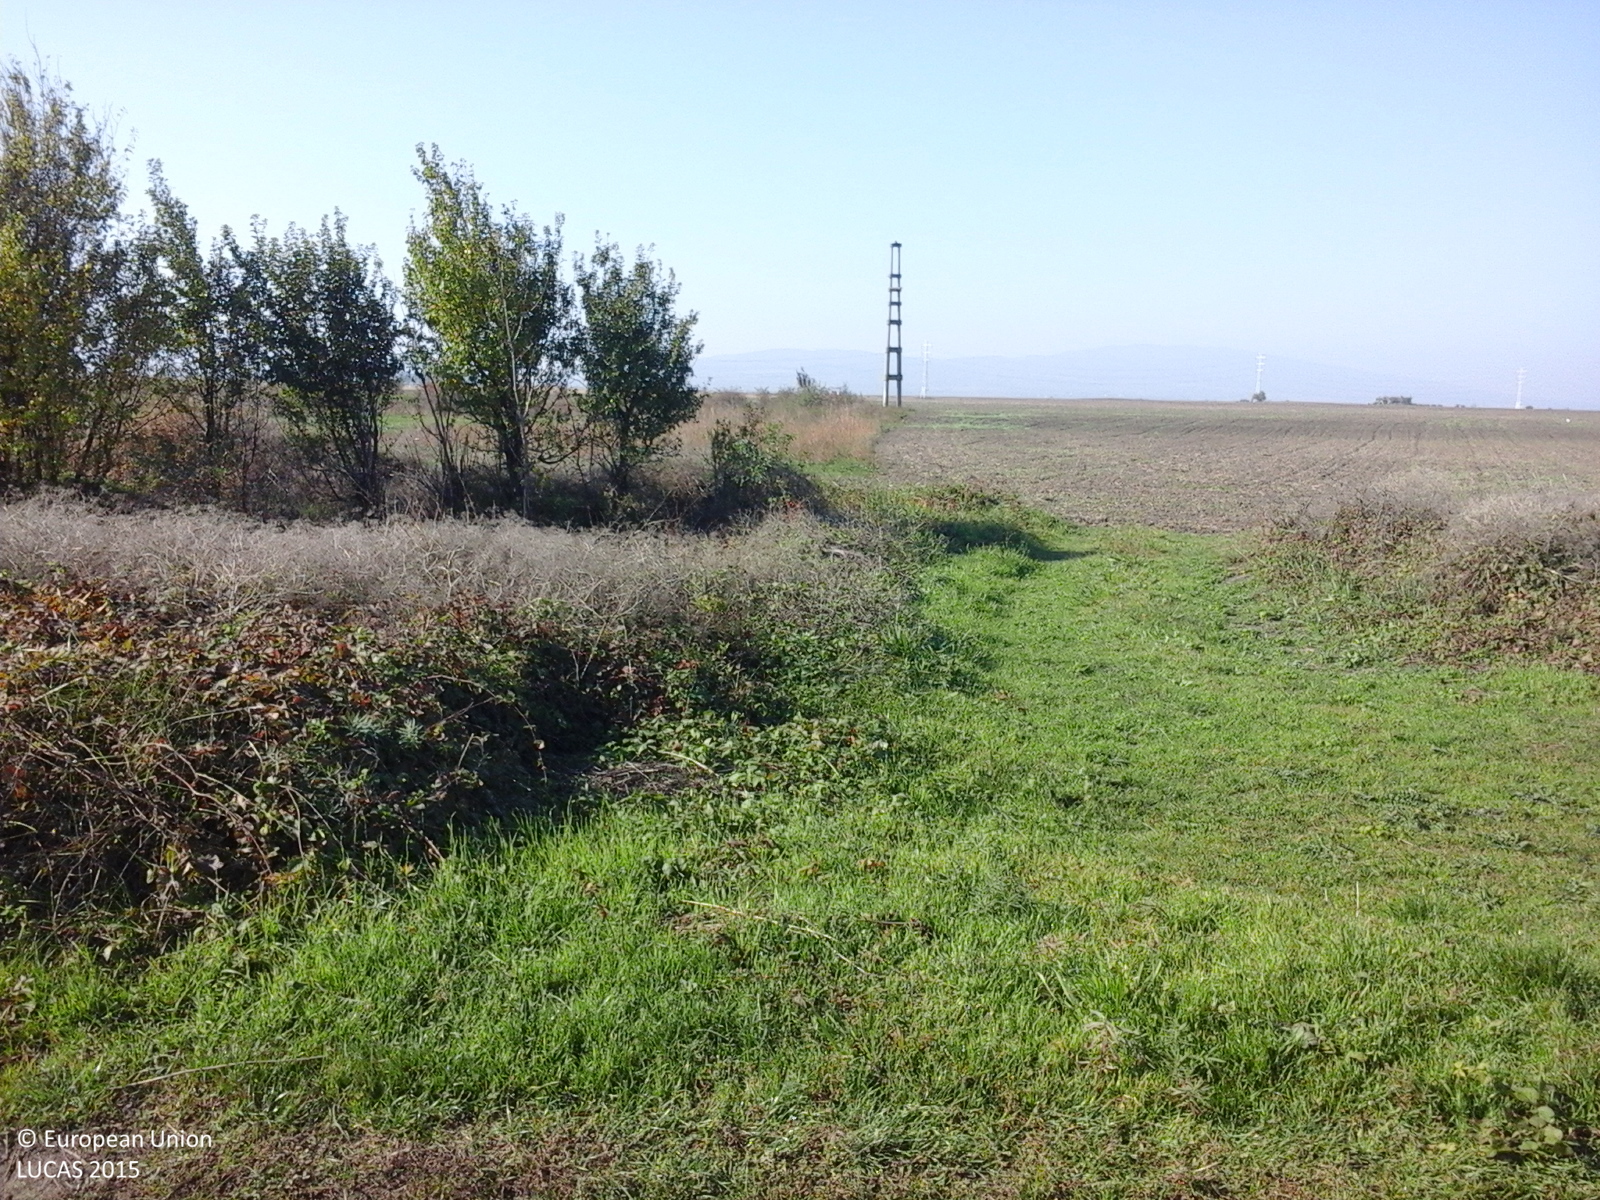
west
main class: Cropland
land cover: Rape and turnip rape
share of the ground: > 75 %
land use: Agriculture (excluding fallow land and kitchen gardens)
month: October
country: RO
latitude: 45.7396
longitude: 27.1756
